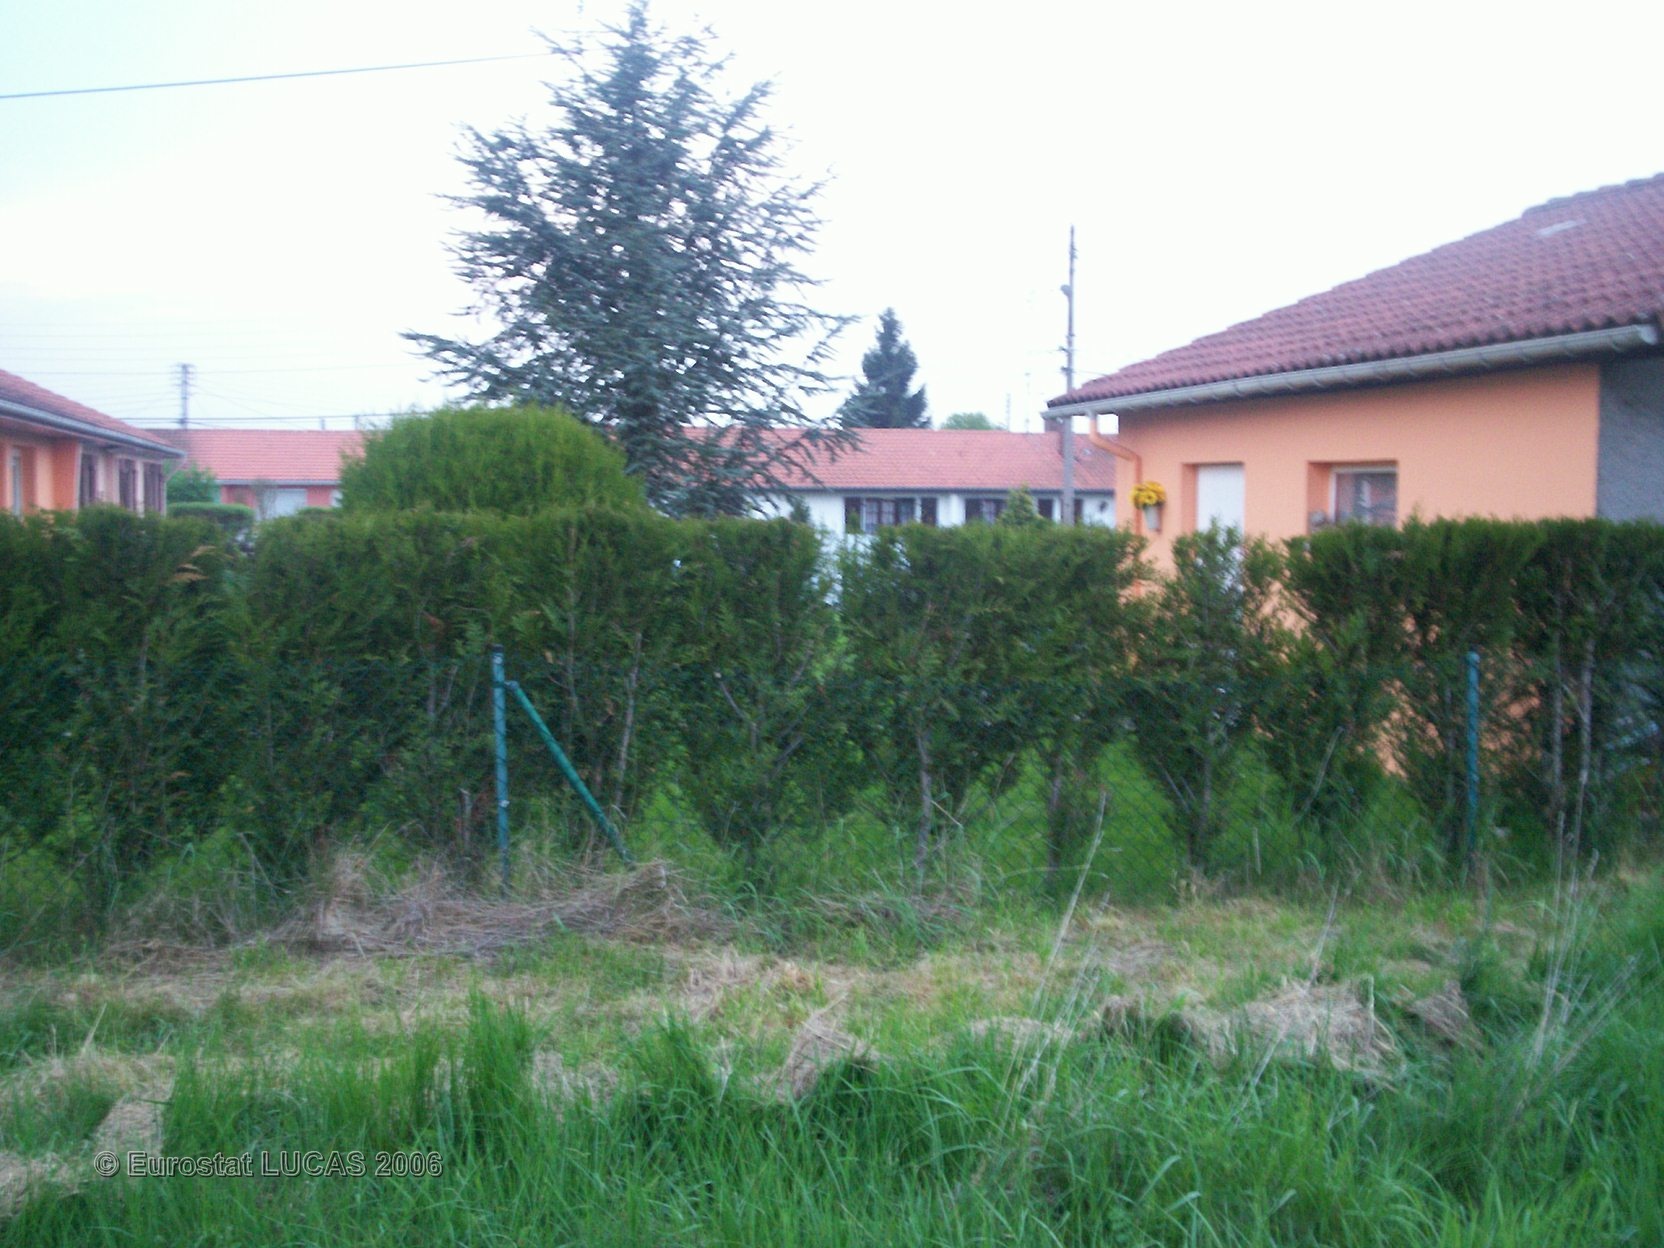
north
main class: Grassland
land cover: Grassland without tree/shrub cover
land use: Agriculture (excluding fallow land and kitchen gardens)
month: May
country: FR
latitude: 48.7430
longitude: 7.0768
